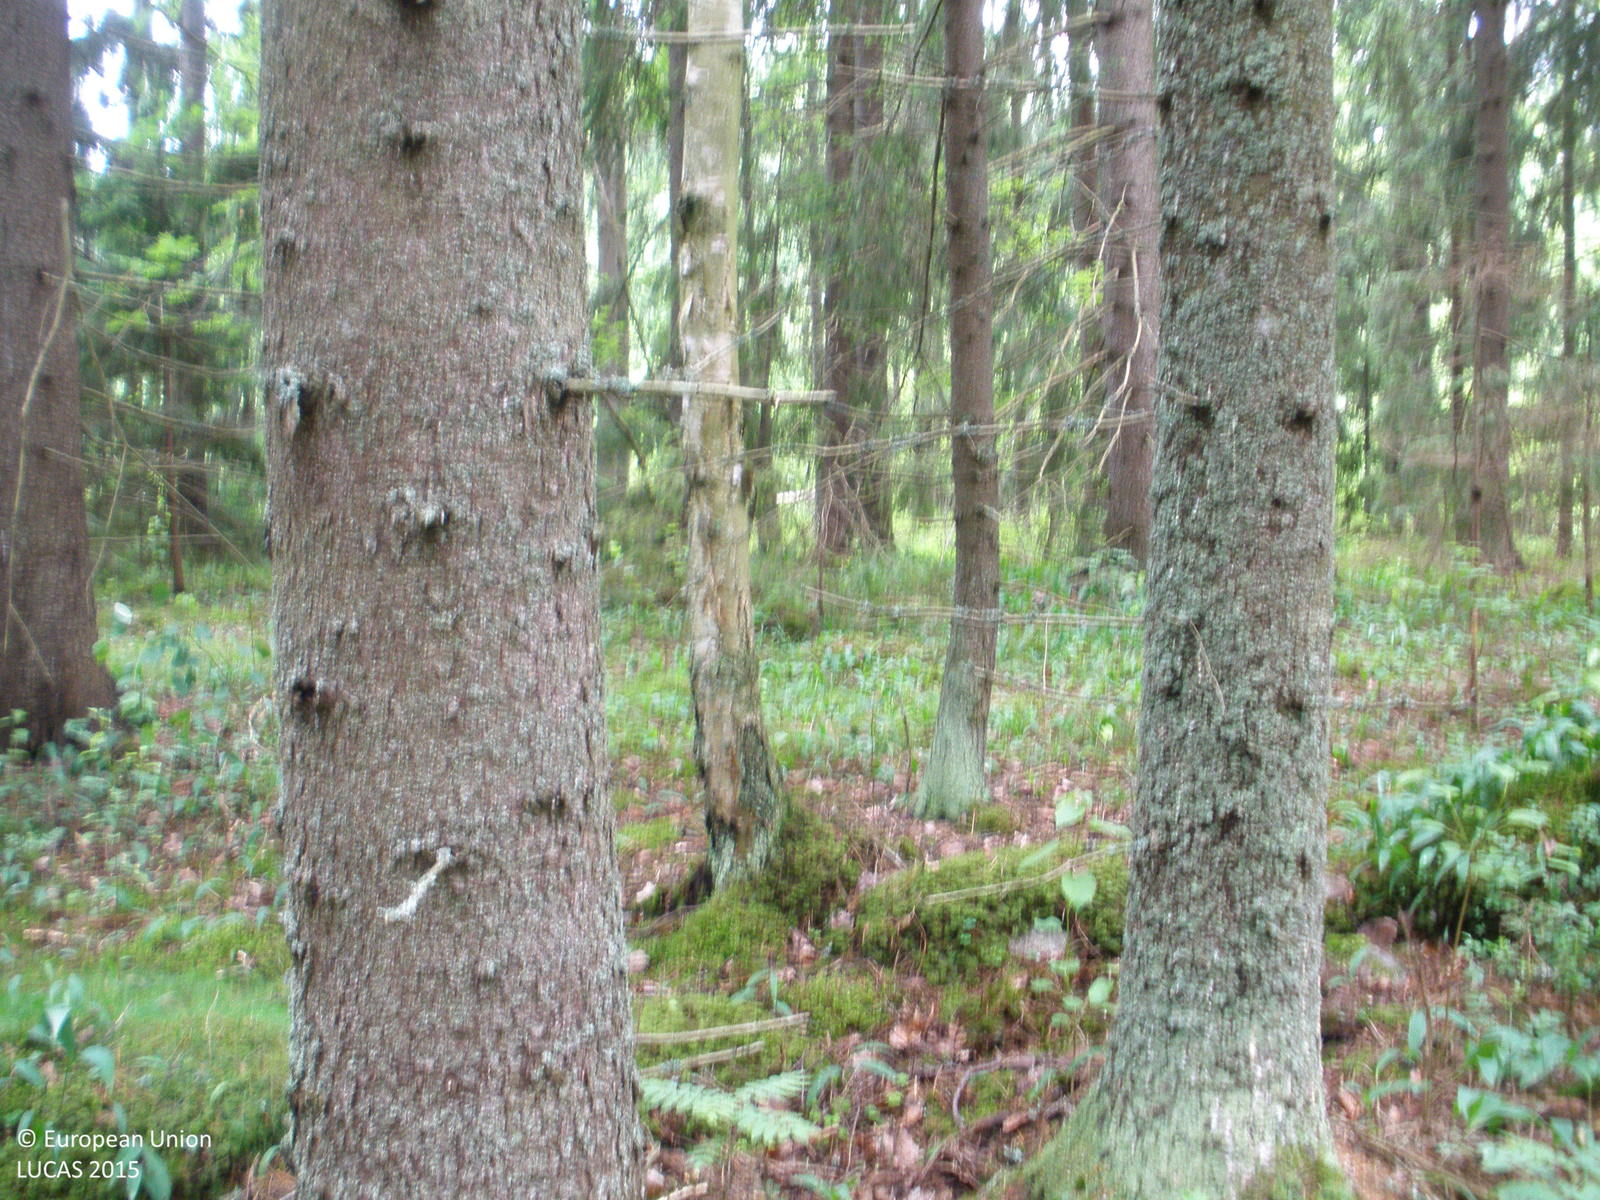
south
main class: Woodland
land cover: Spruce dominated coniferous woodland
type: boreal forest
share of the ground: > 75 %
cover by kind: coniferous forest trees 80 %, herbaceous plants 10 %, broadleaved forest trees 5 %, lichens and mosses 5 %
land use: Forestry
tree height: > 5 m
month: July
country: FI
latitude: 61.3392
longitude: 23.7097
